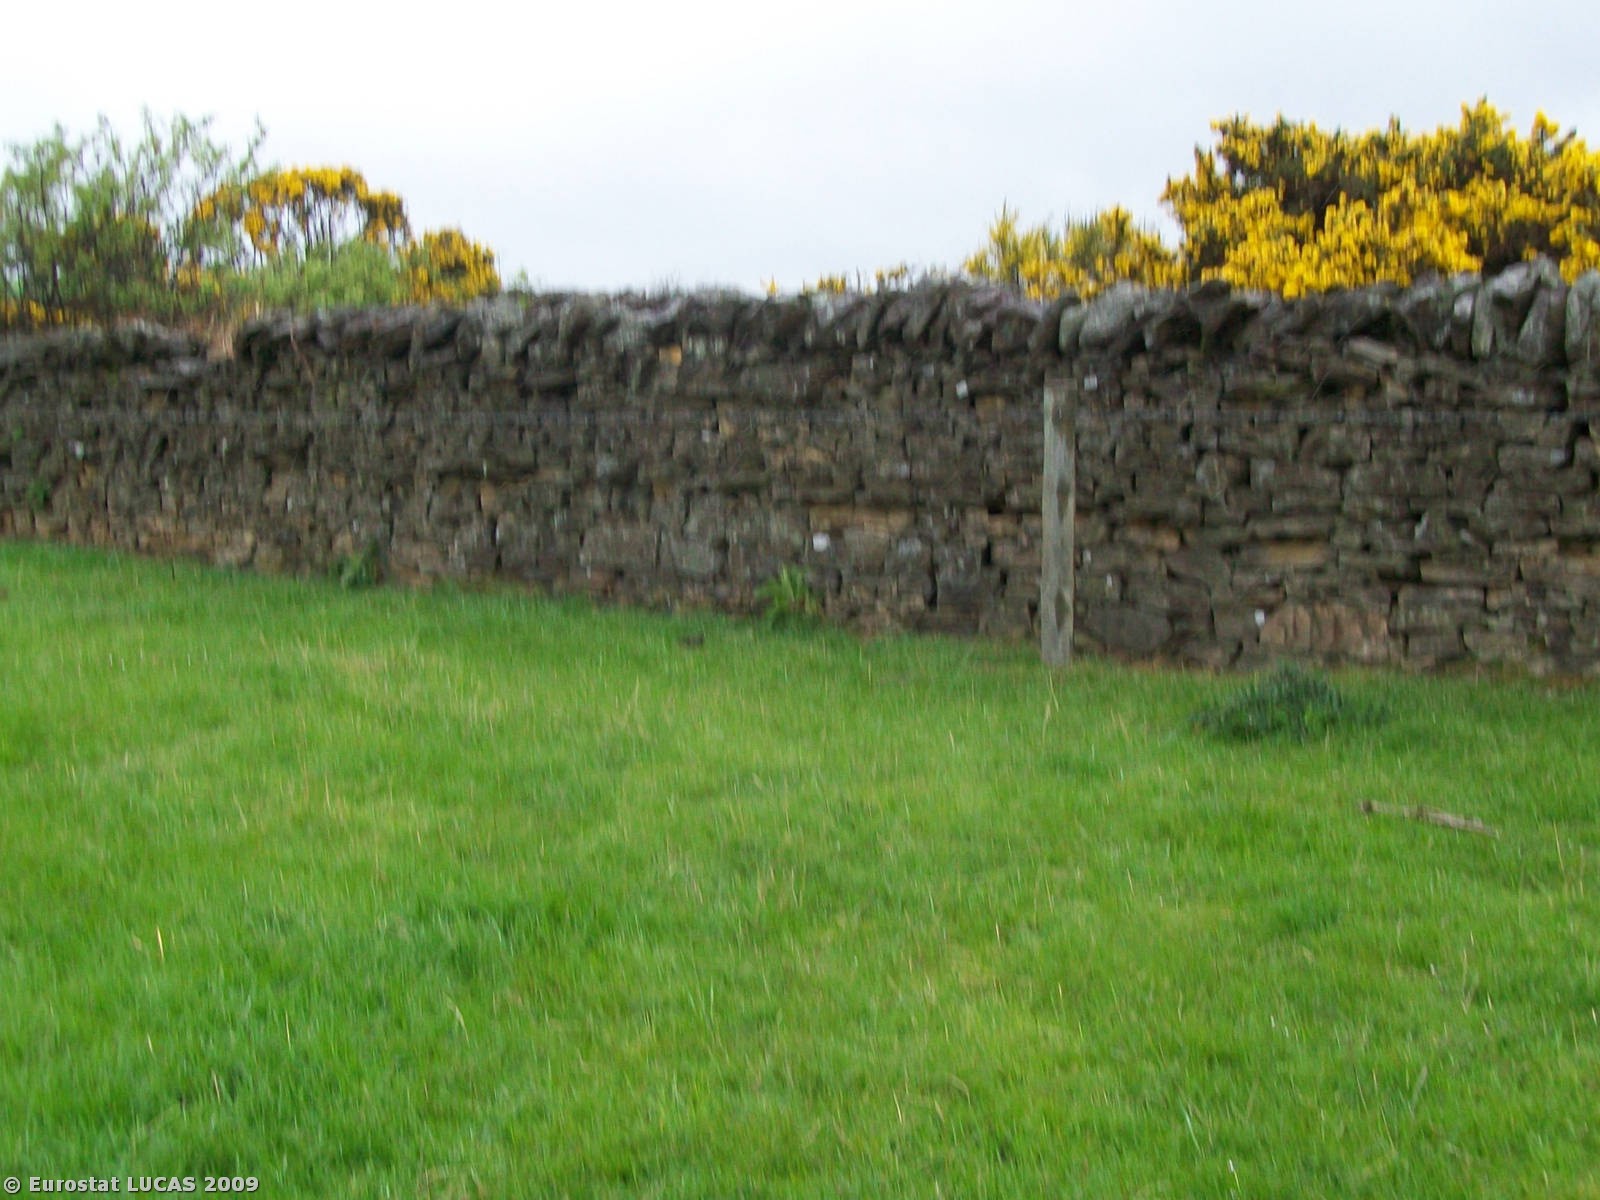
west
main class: Grassland
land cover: Grassland without tree/shrub cover
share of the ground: > 75 %
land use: Agriculture (excluding fallow land and kitchen gardens)
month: May
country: GB
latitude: 54.9343
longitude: -1.9627
